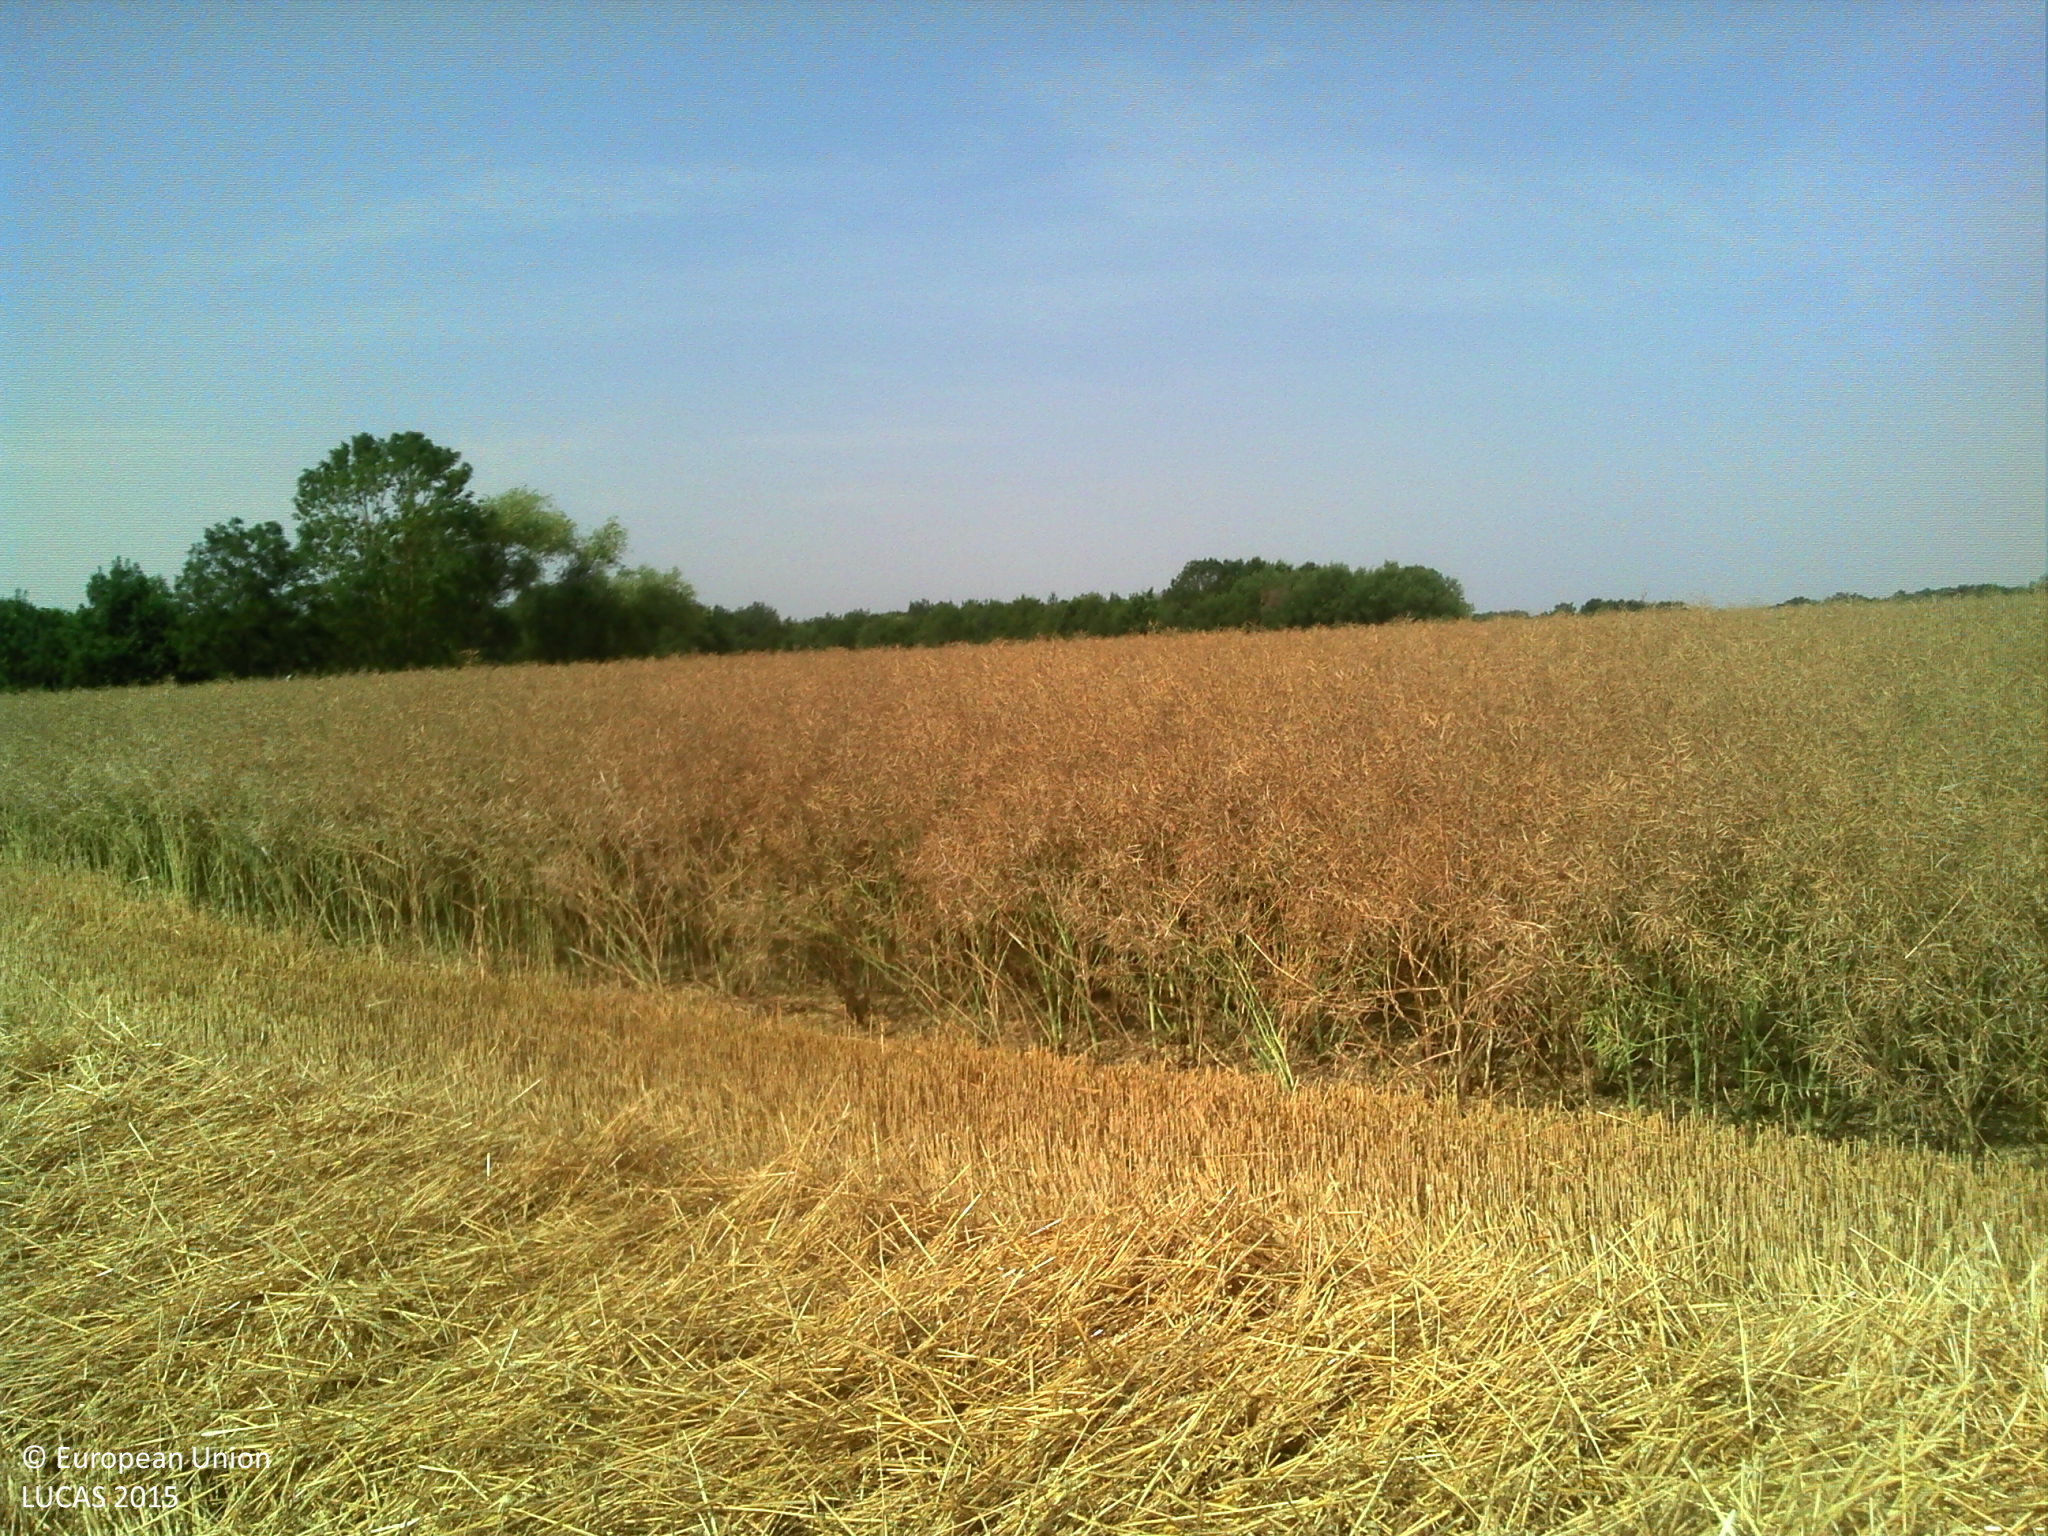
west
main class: Cropland
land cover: Triticale
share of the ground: > 75 %
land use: Agriculture (excluding fallow land and kitchen gardens)
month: July
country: FR
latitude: 46.8621
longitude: 5.3188
